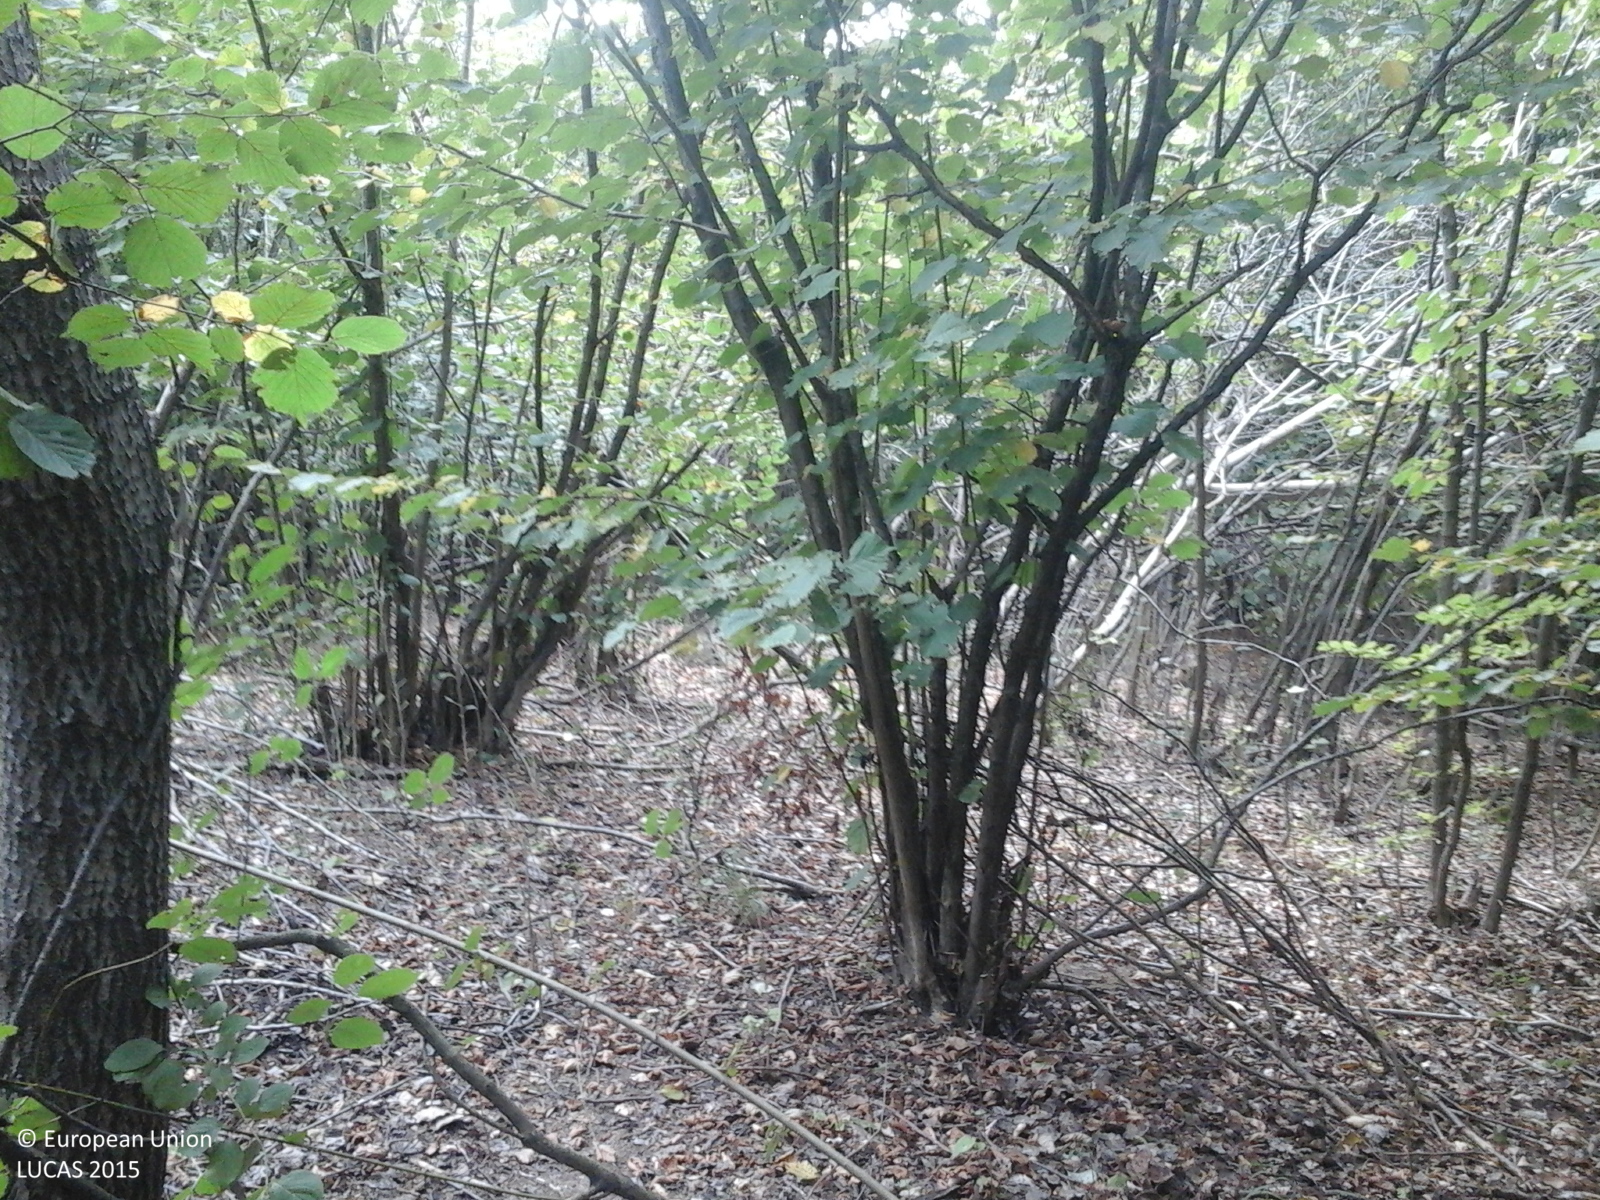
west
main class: Woodland
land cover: Broadleaved woodland
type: non-riverine alder, birch or aspen forest
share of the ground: > 75 %
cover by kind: broadleaved forest trees 100 %
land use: Forestry
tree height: > 5 m
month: September
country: RO
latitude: 47.9509
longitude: 23.6703
